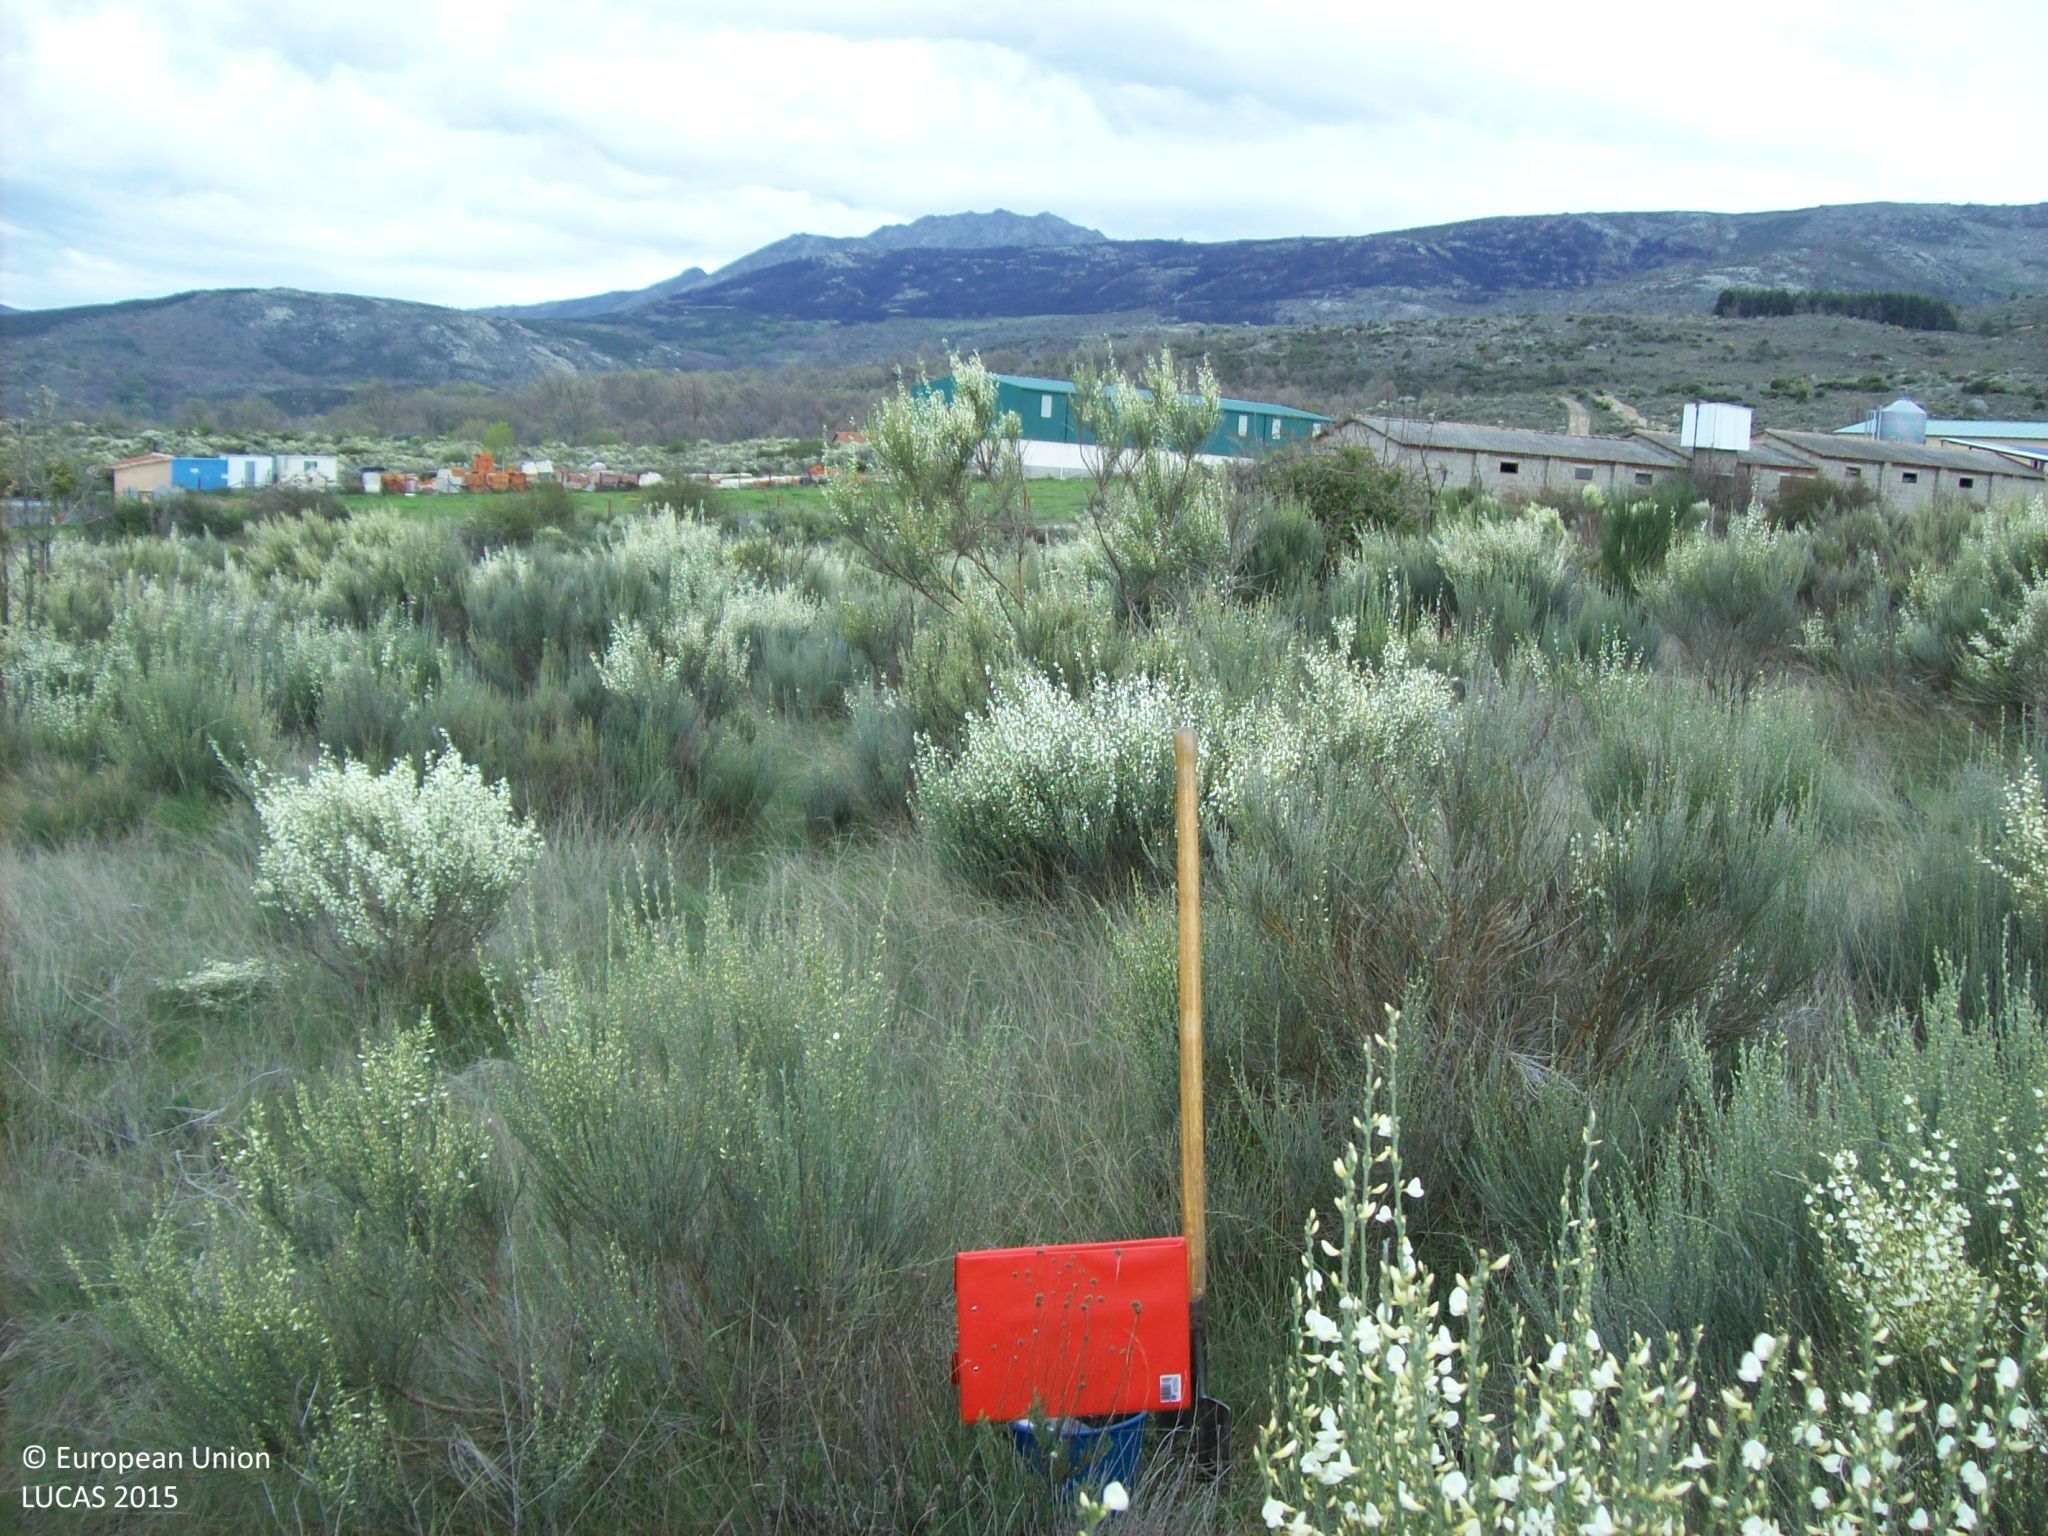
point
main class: Shrubland
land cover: Shrubland with sparse tree cover
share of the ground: > 75 %
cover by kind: shrubs 60 %, herbaceous plants 20 %, broadleaved forest trees 5 %
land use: Semi-natural and natural areas not in use
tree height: < 5 m
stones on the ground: < 10 %
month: April
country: ES
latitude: 40.3735
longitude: -4.8827
